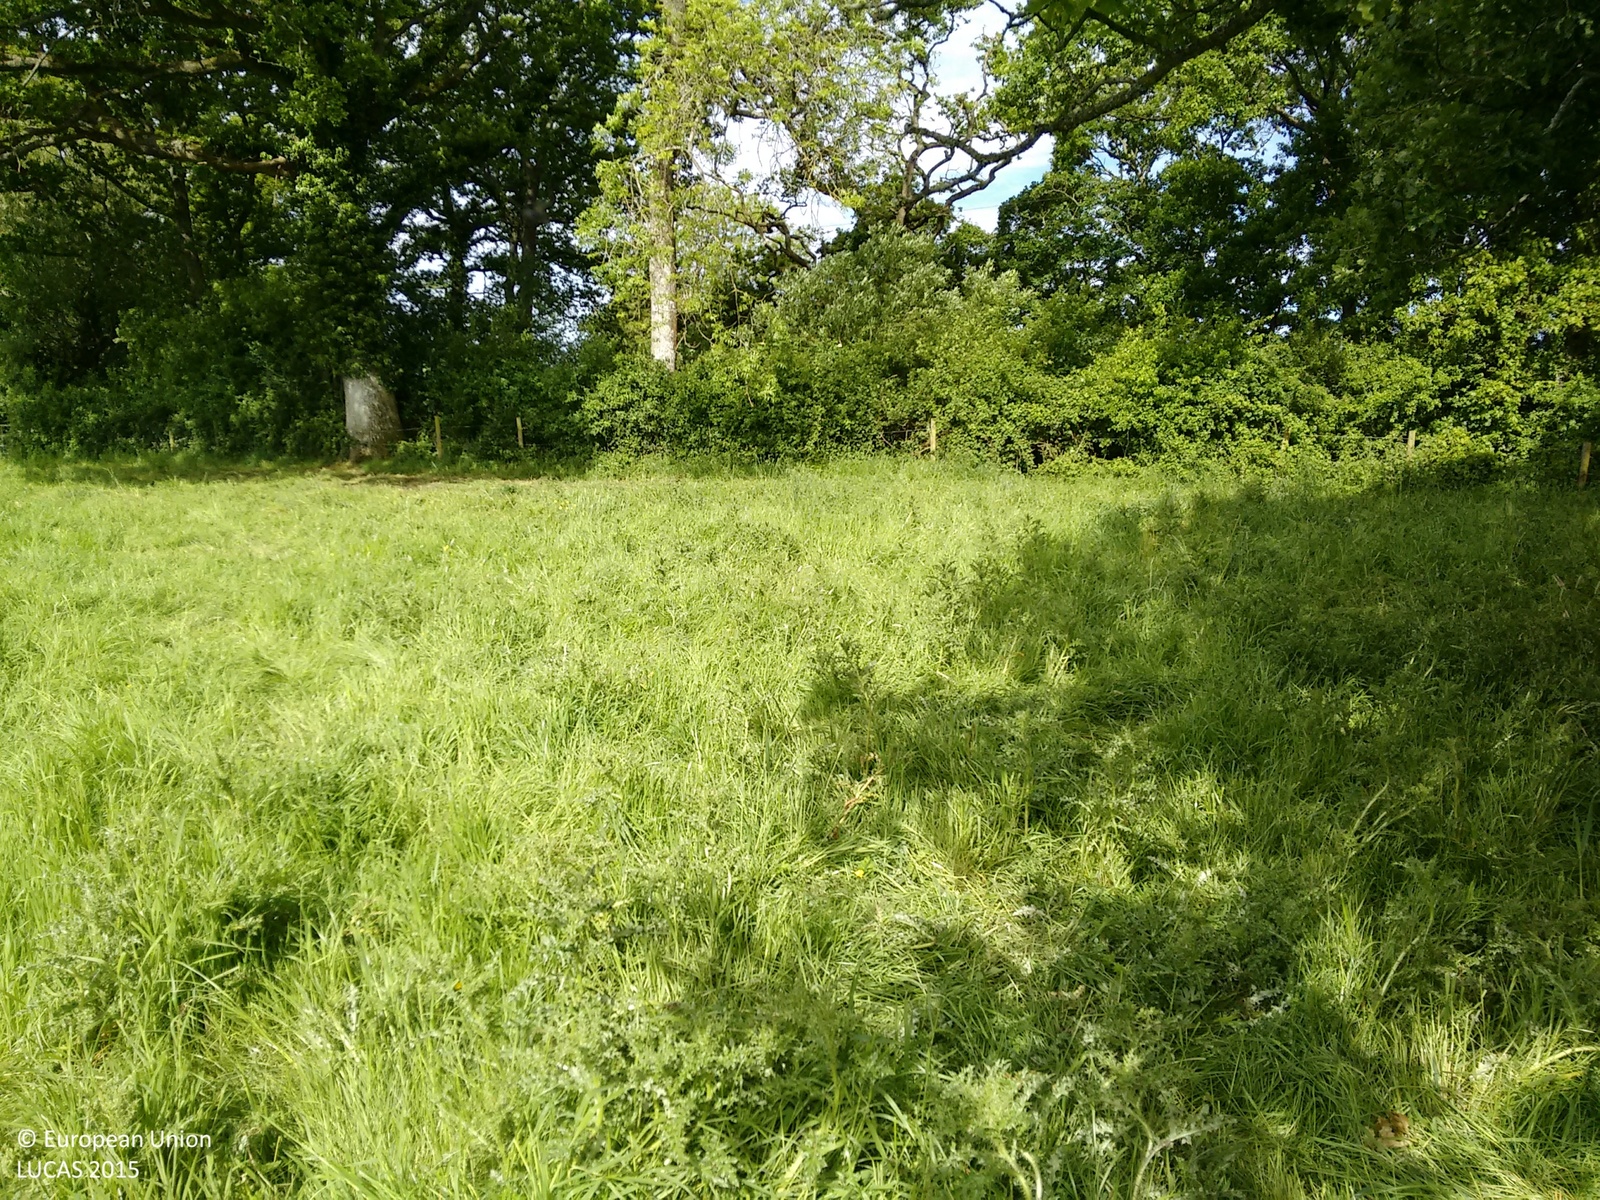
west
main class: Grassland
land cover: Grassland without tree/shrub cover
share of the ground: > 75 %
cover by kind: herbaceous plants 100 %
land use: Agriculture (excluding fallow land and kitchen gardens)
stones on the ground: < 10 %
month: June
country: GB
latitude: 51.0686
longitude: -2.2350
